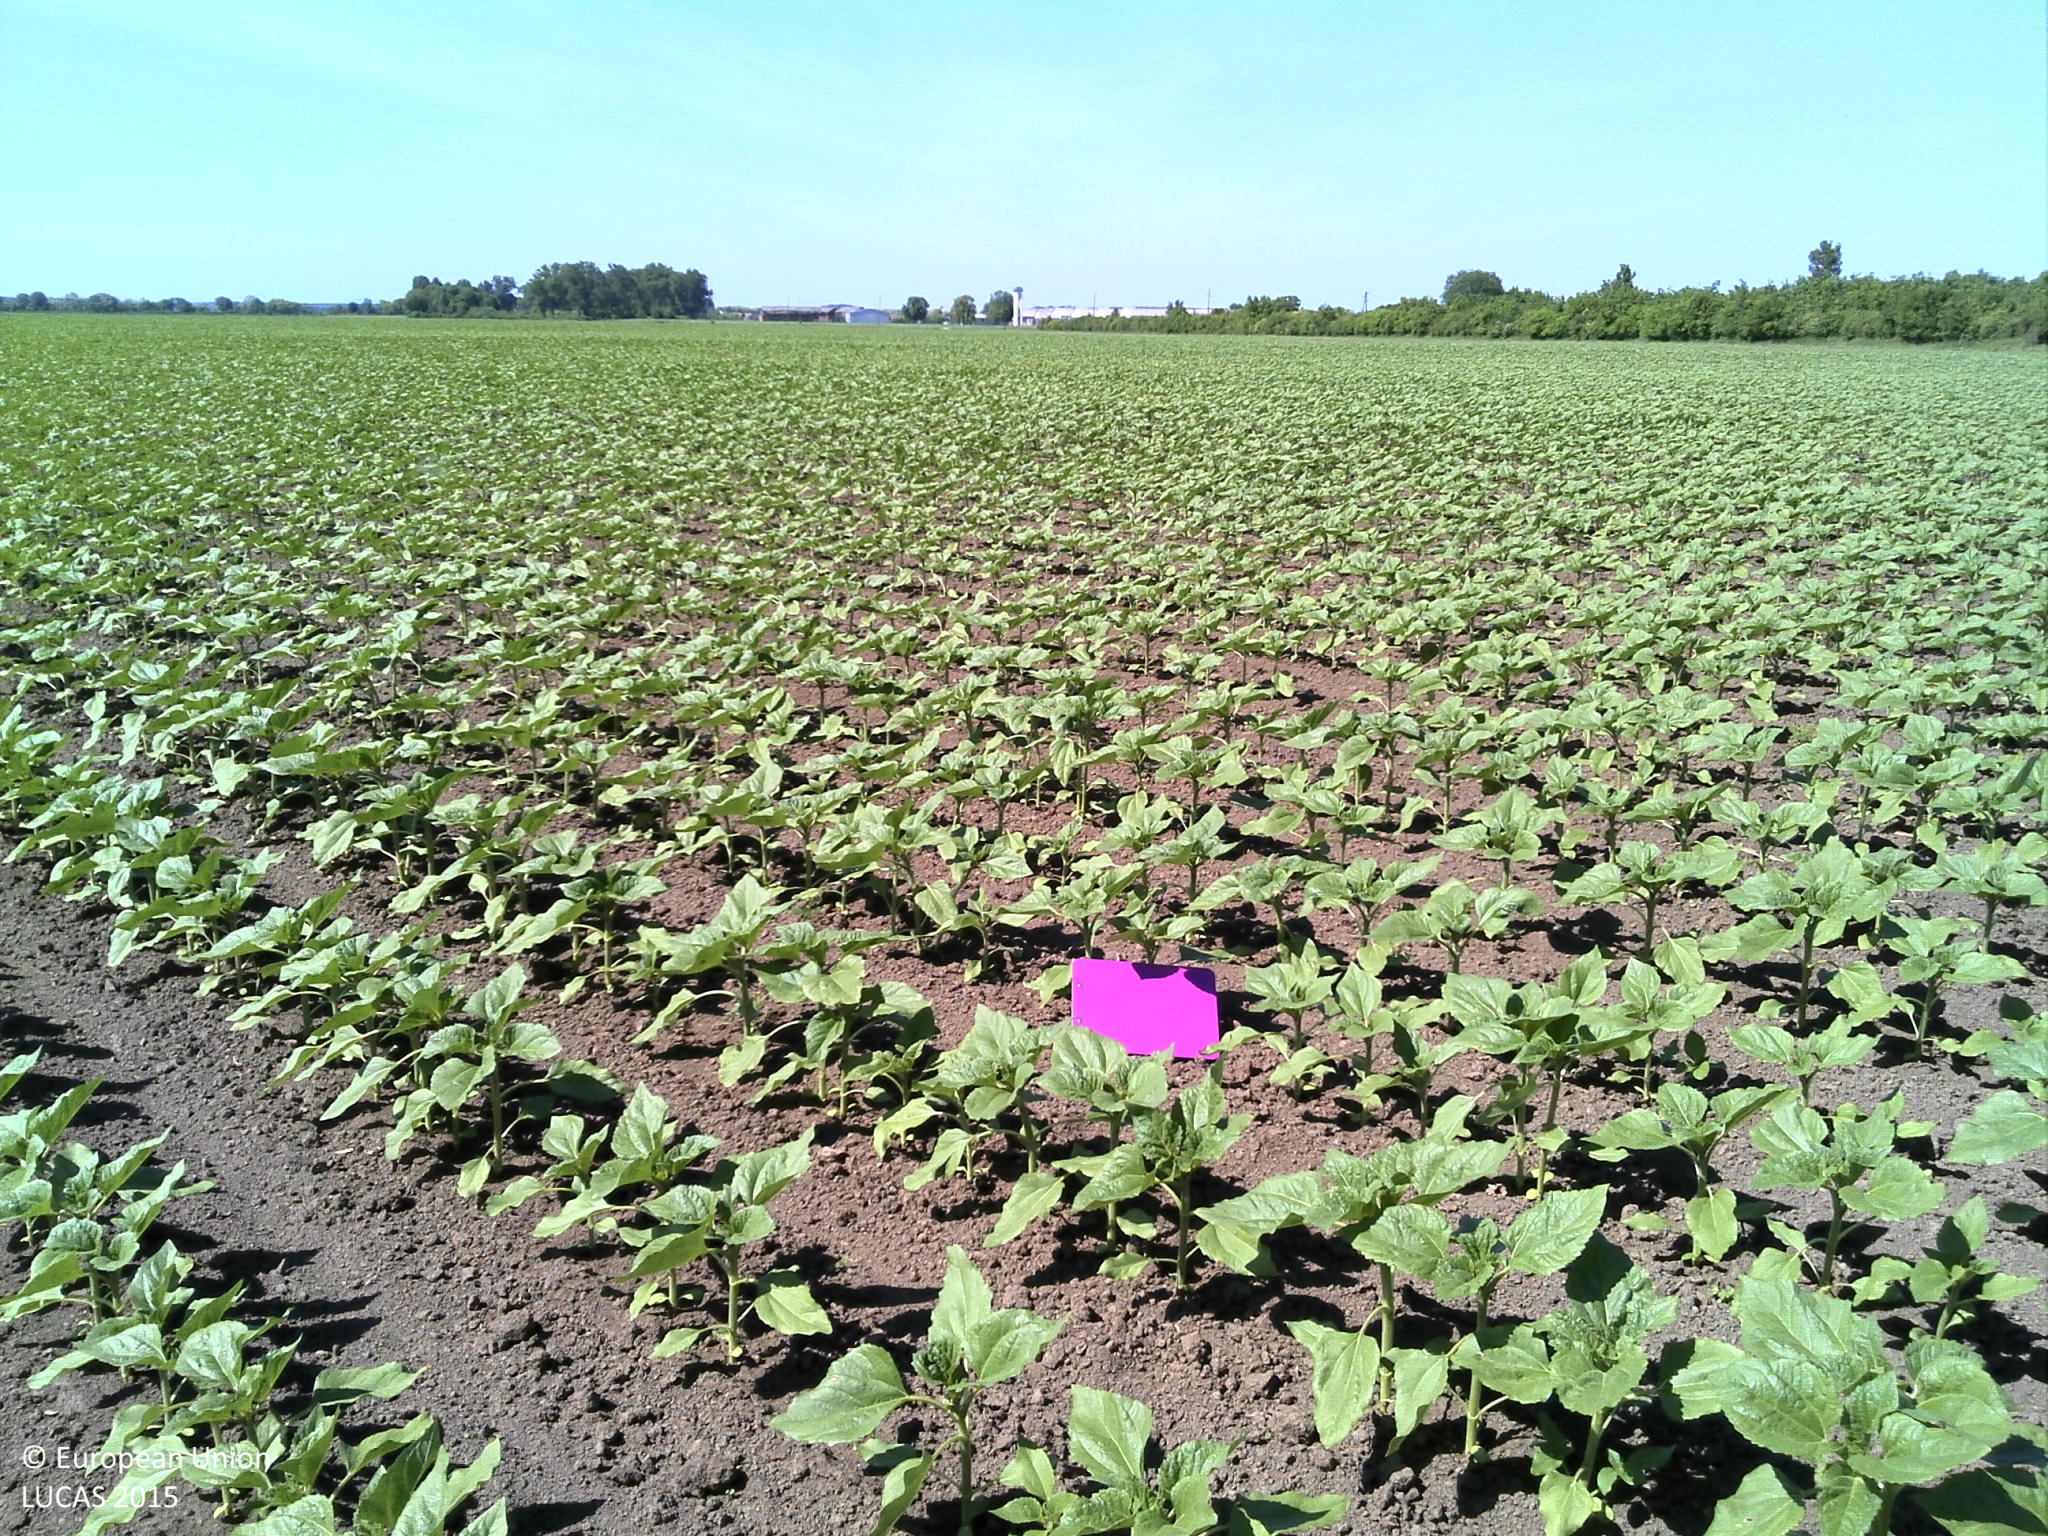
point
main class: Cropland
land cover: Sunflower
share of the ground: 10 - 25 %
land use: Agriculture (excluding fallow land and kitchen gardens)
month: May
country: HR
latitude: 45.8217
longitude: 18.6192
